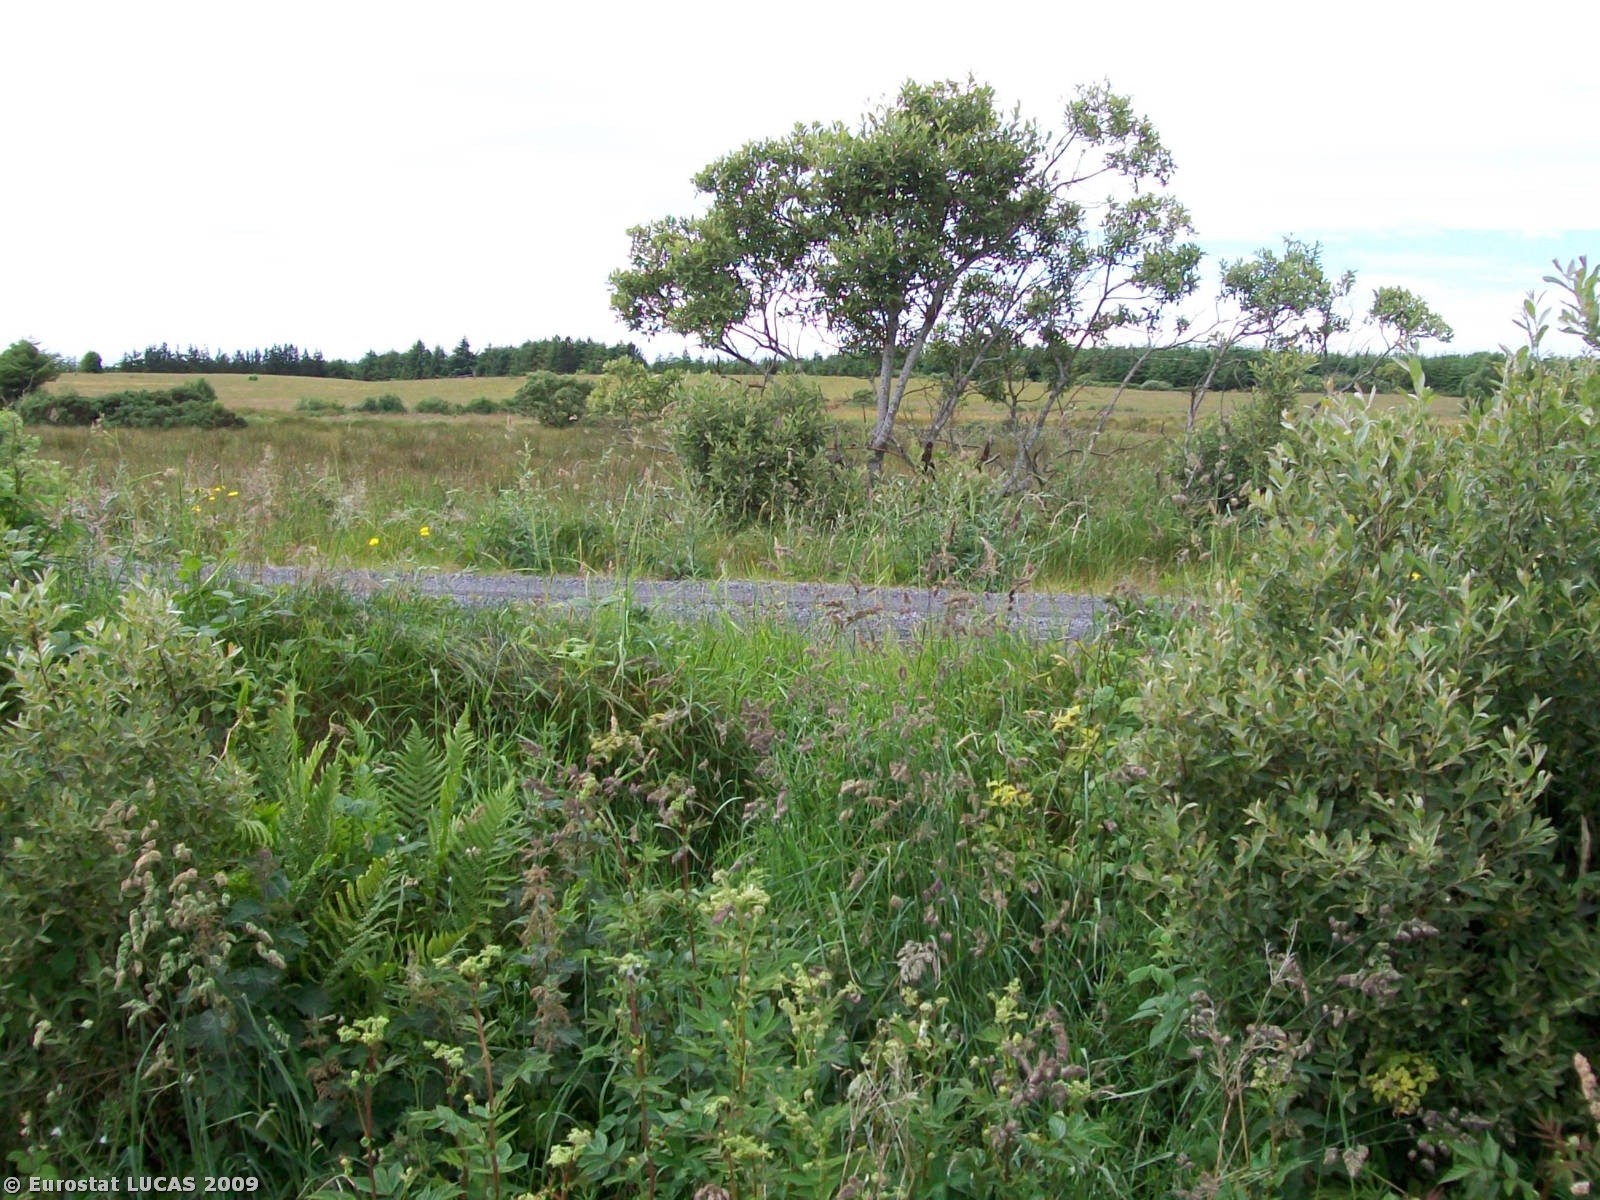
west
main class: Artificial land
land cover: Non built-up linear features
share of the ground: > 75 %
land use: Road transport
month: June
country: IE
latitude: 53.8027
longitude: -8.9942
